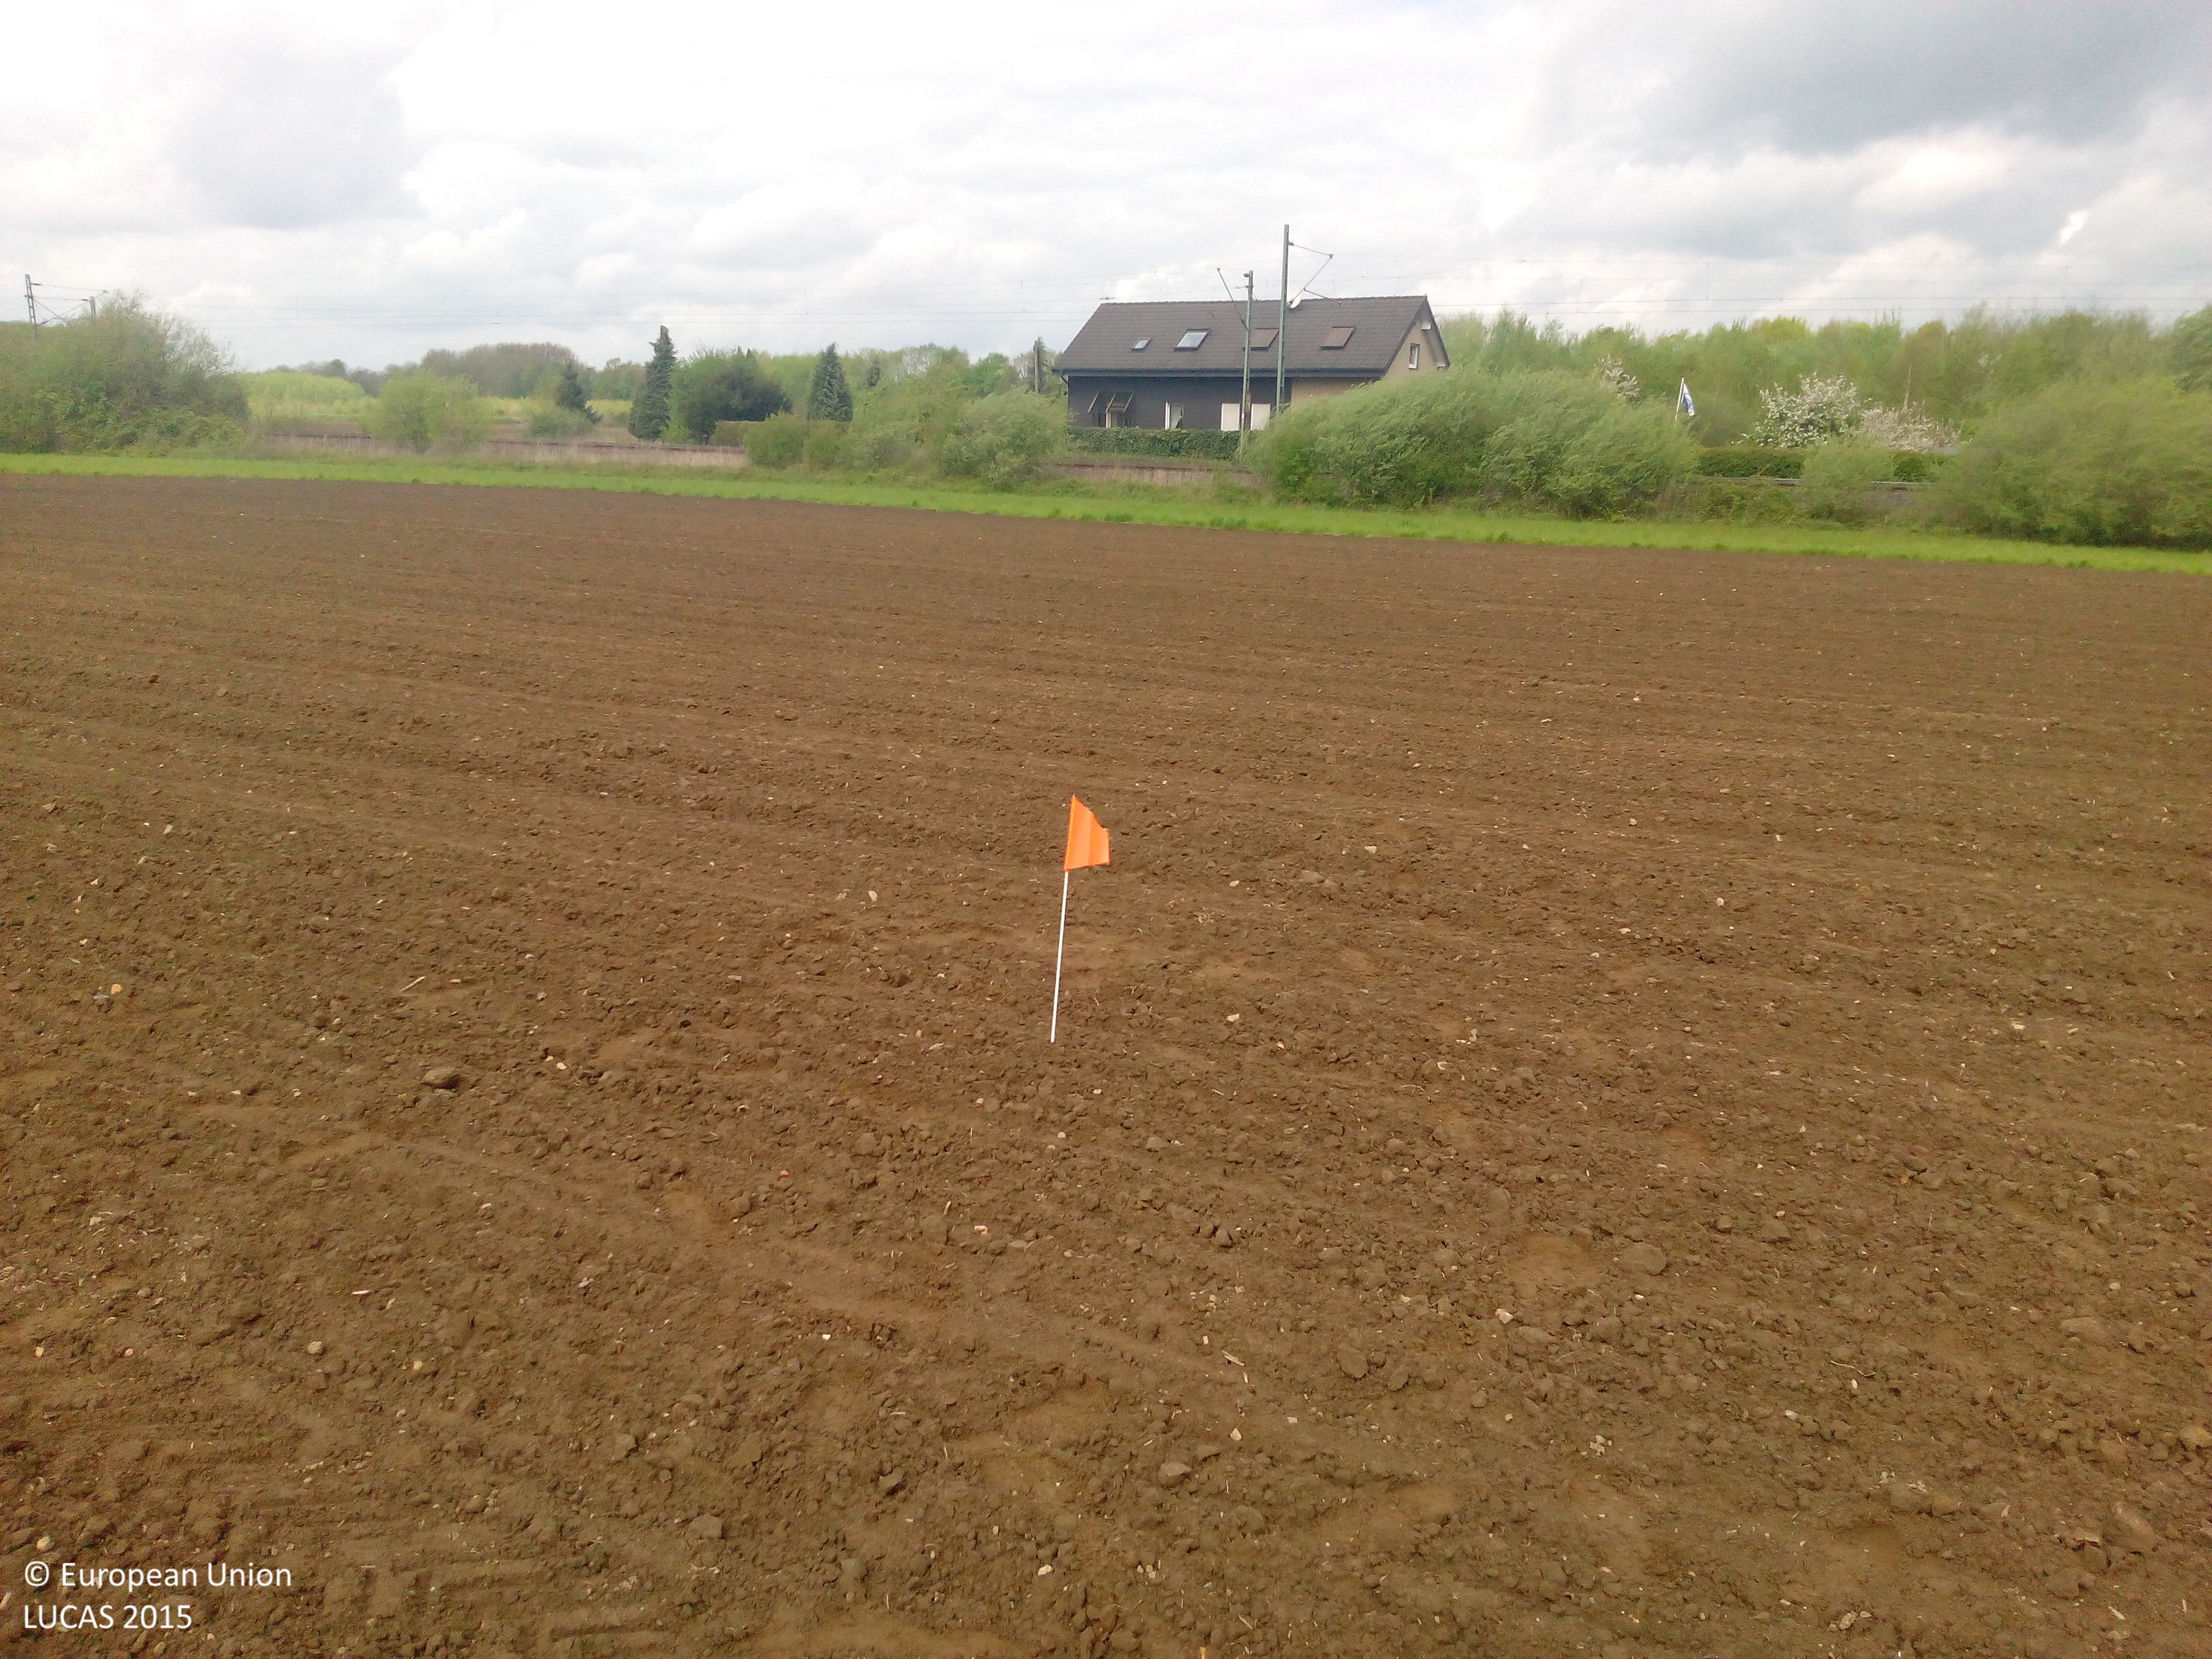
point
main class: Cropland
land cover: Maize
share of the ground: < 10 %
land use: Agriculture (excluding fallow land and kitchen gardens)
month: May
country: DE
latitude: 51.9007
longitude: 7.4569
